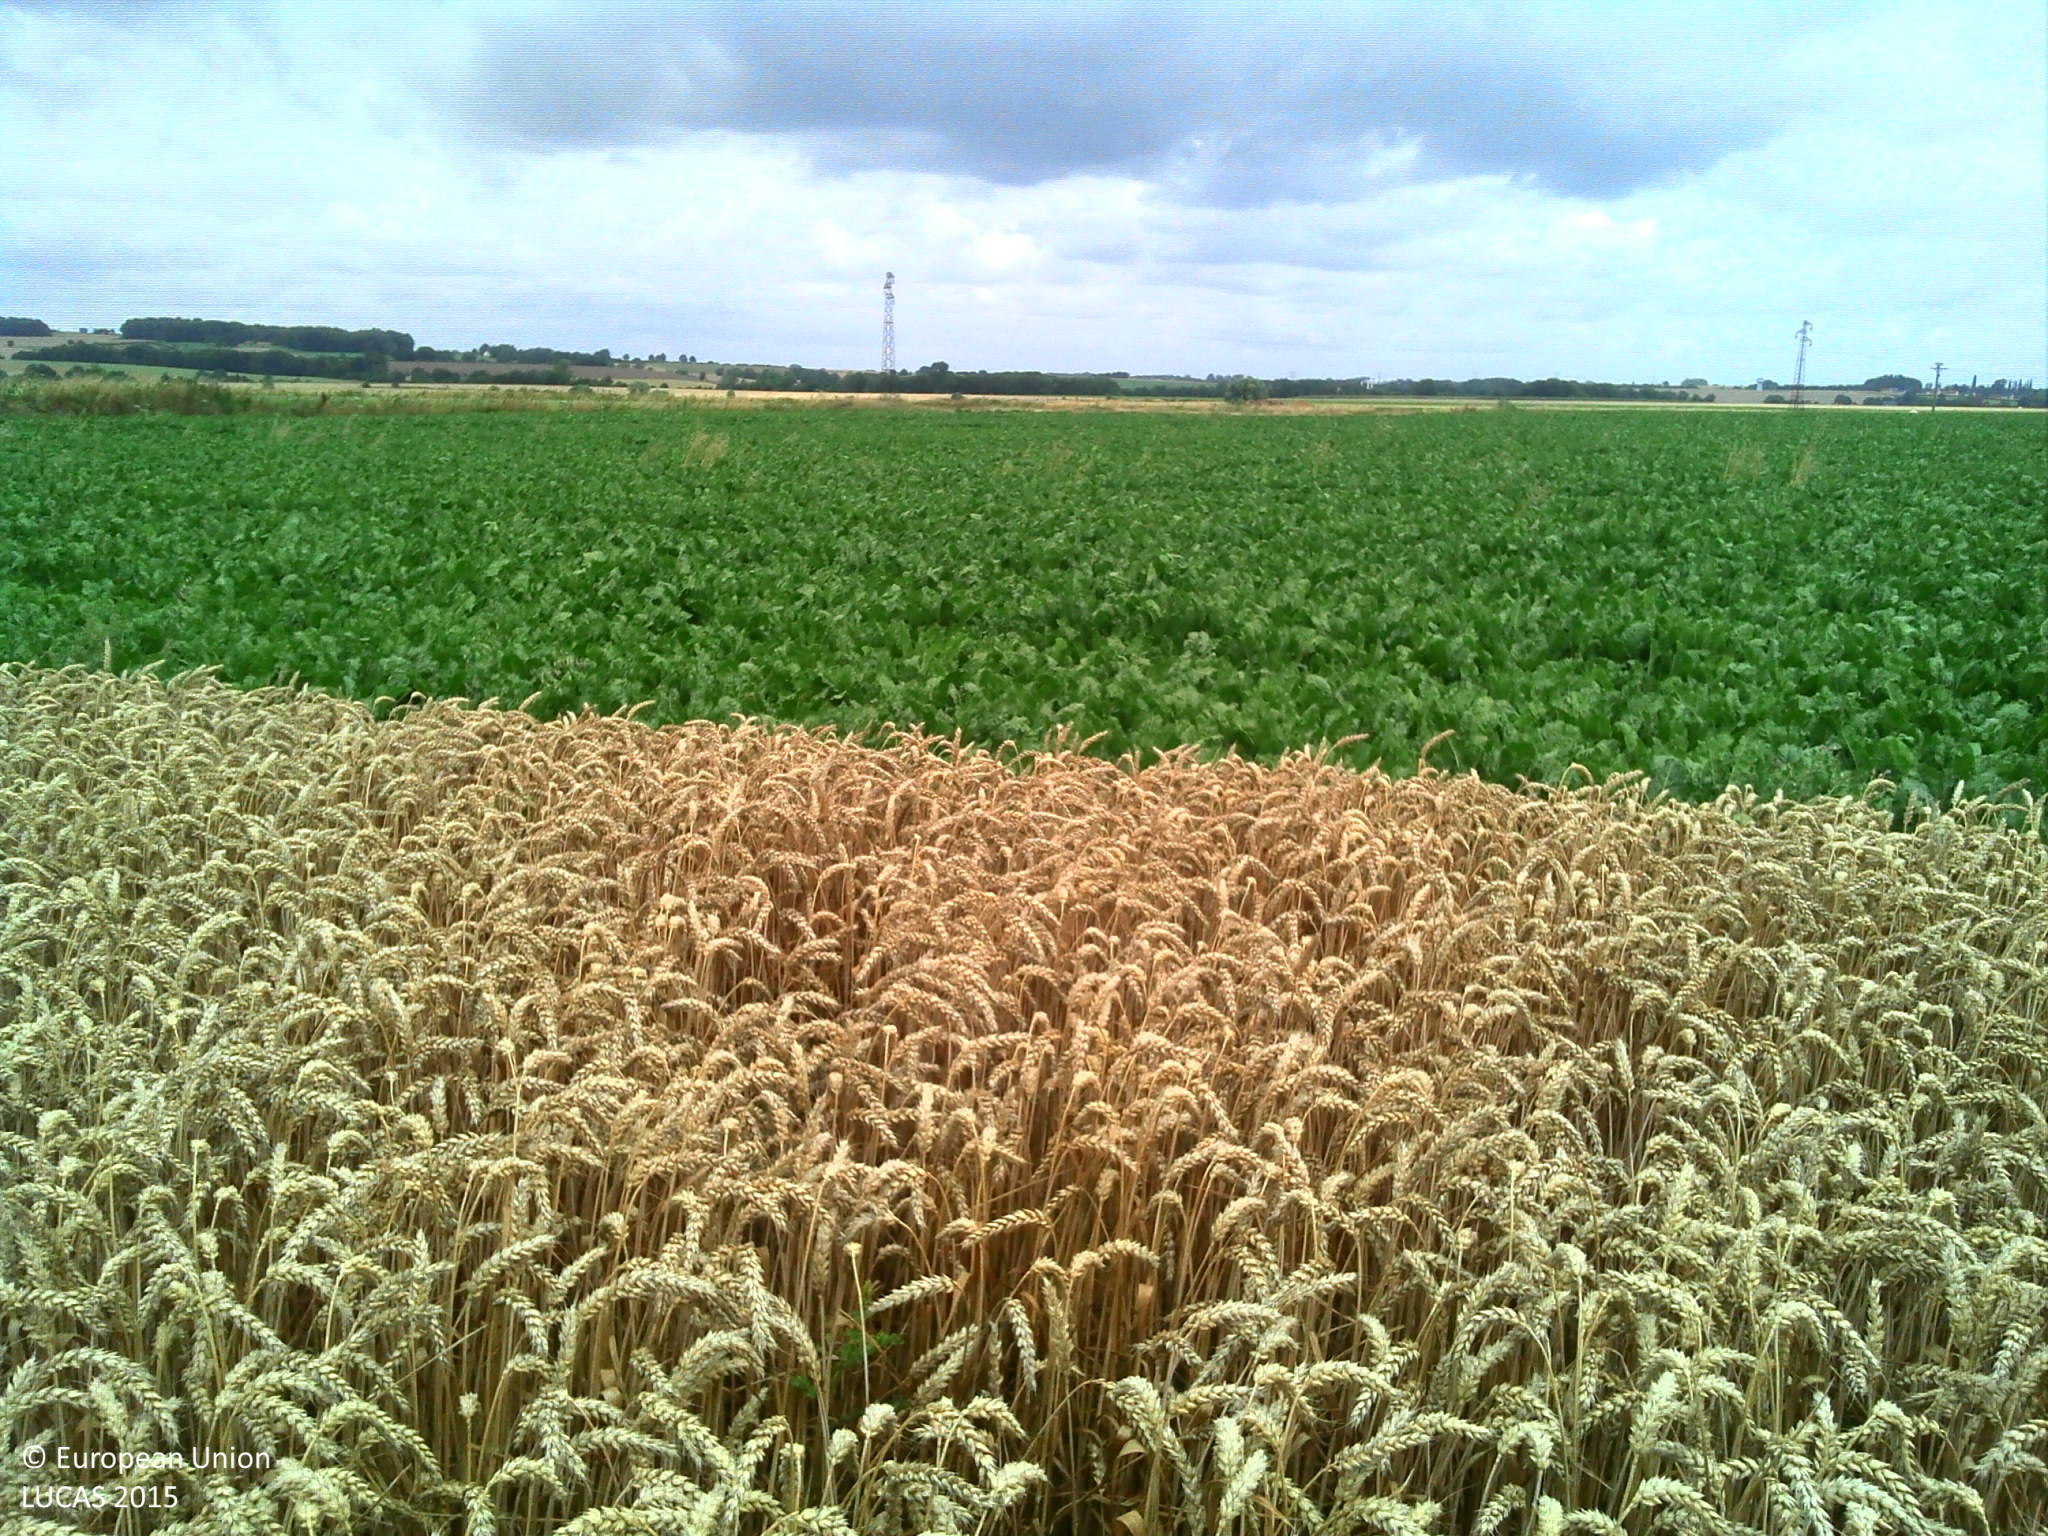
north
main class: Cropland
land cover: Common wheat
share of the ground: > 75 %
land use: Agriculture (excluding fallow land and kitchen gardens)
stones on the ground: < 10 %
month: July
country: FR
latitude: 49.9711
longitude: 3.6492
